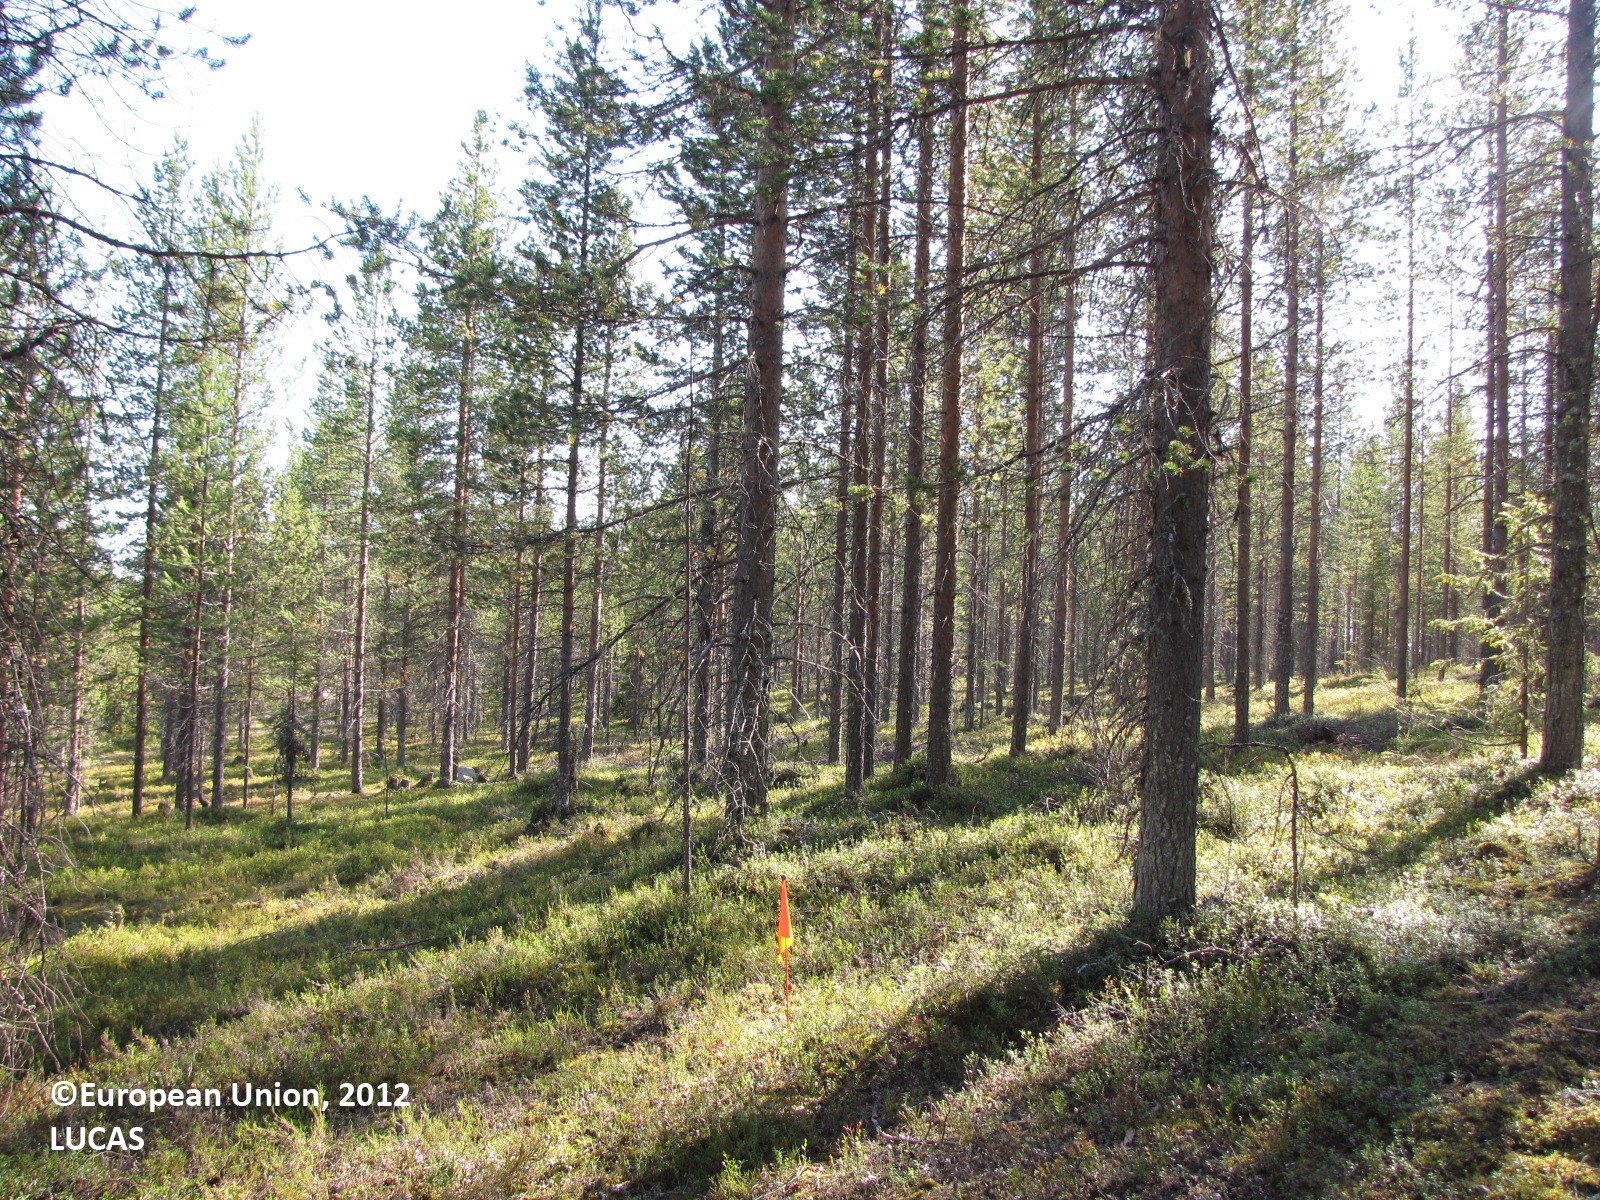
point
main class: Woodland
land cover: Pine dominated coniferous woodland
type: boreal forest
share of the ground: 25 - 50 %
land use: Forestry
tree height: > 5 m
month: August
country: FI
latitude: 67.0071
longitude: 25.2150
